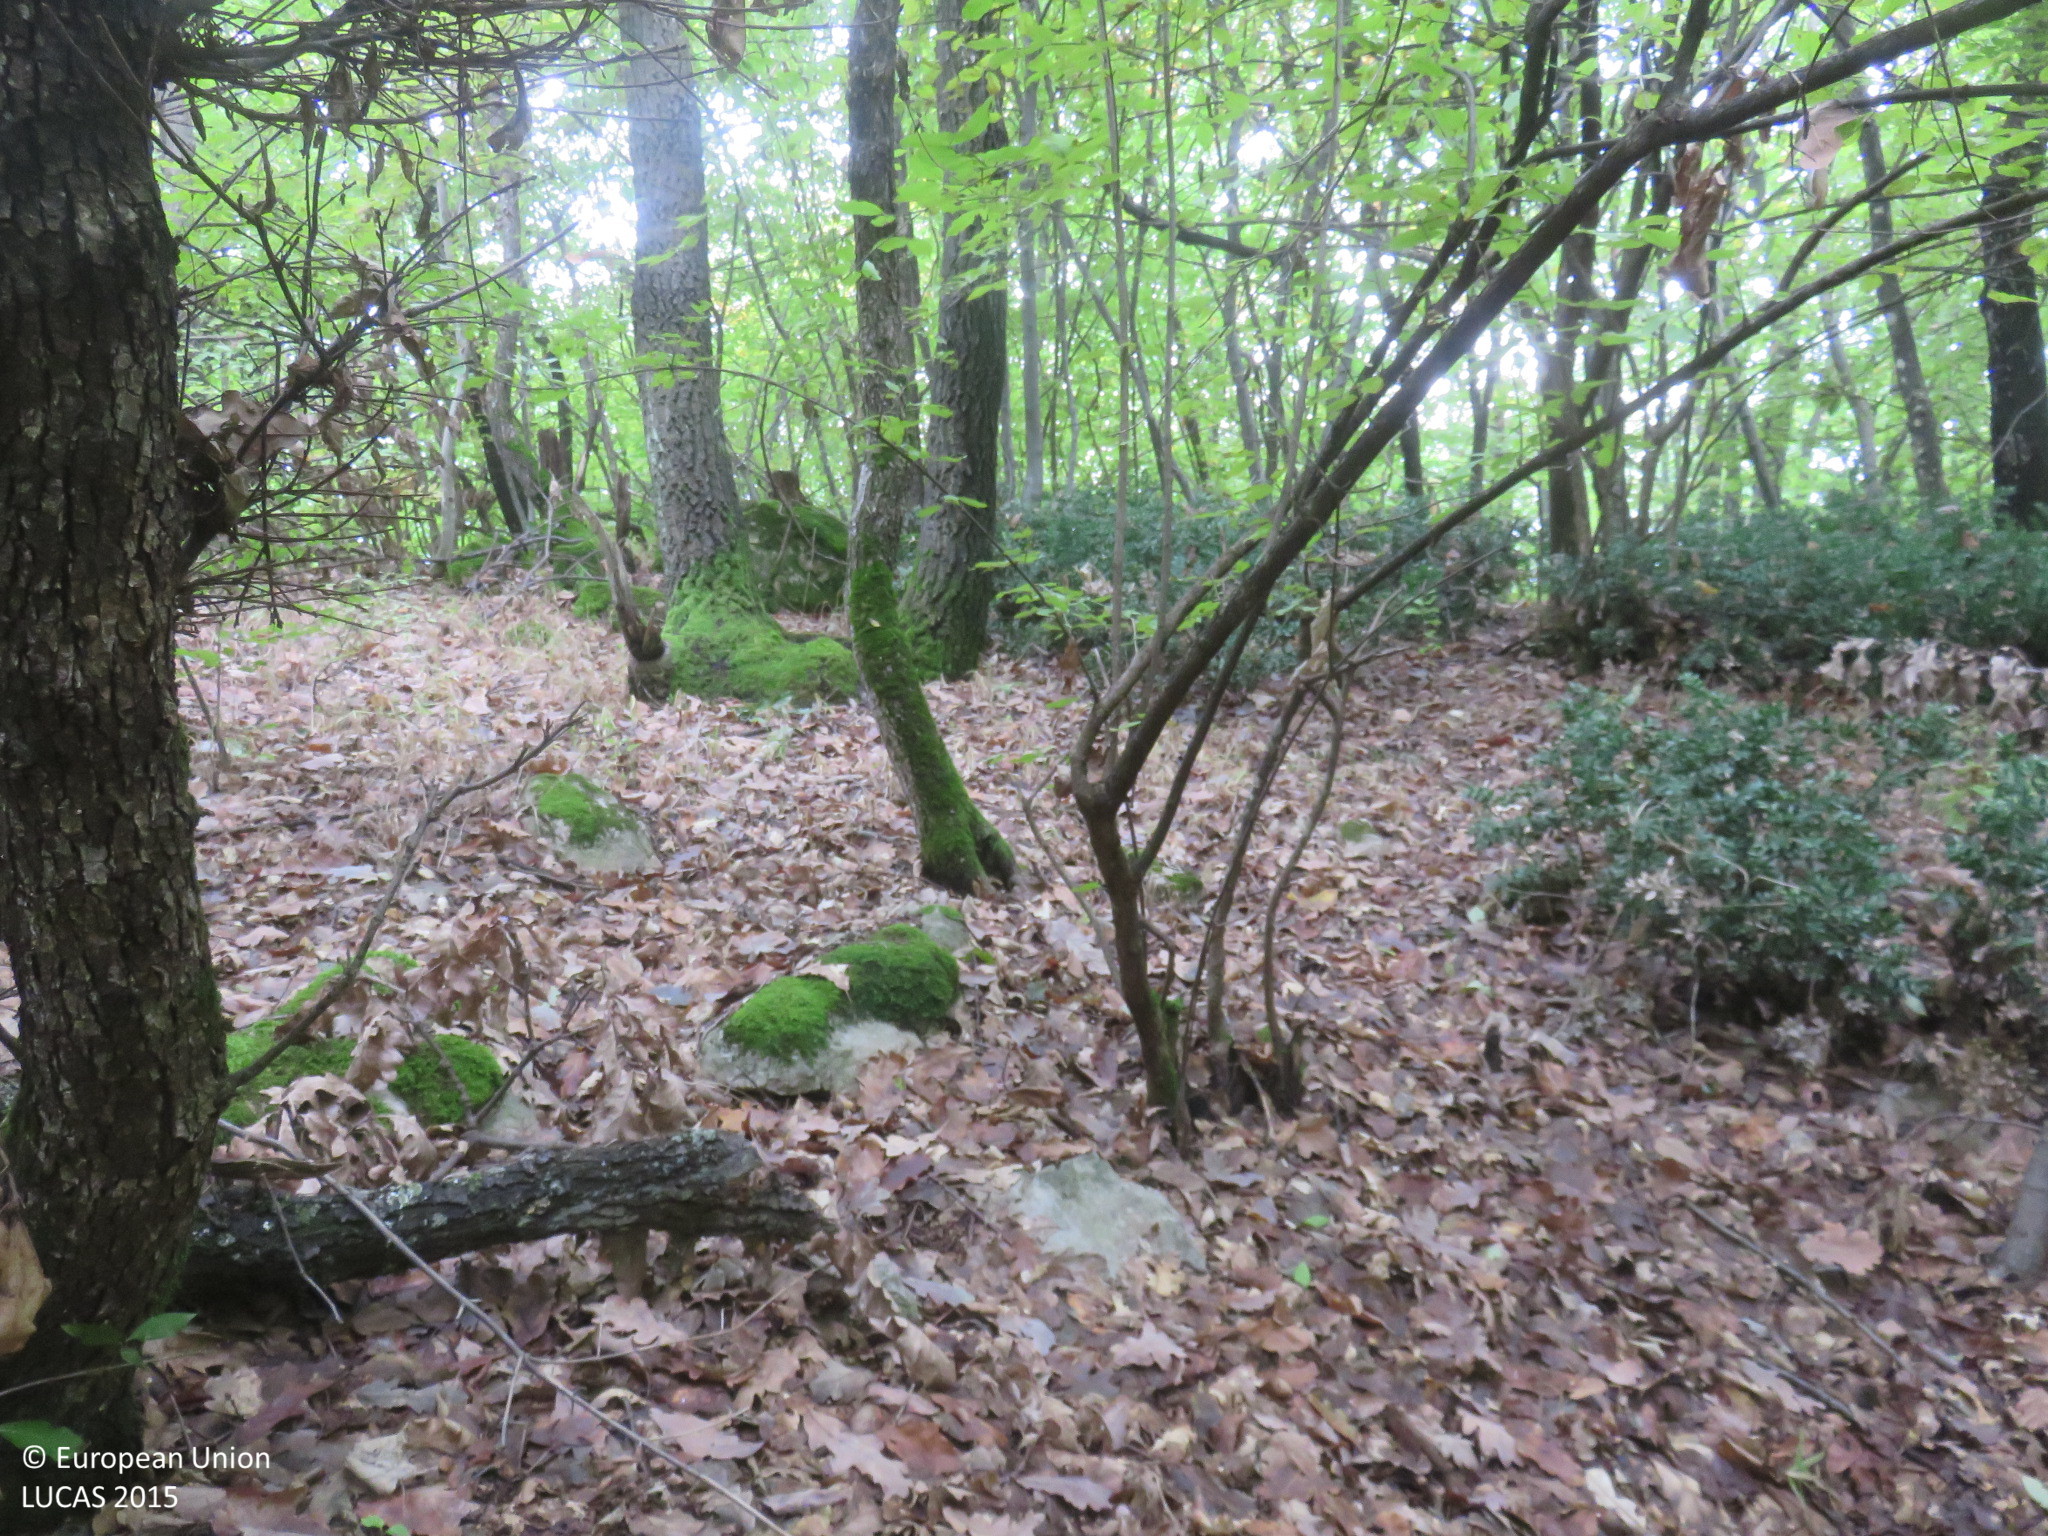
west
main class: Woodland
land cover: Broadleaved woodland
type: mesophytic deciduous forest
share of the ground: > 75 %
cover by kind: broadleaved forest trees 85 %, unconsolidated bare surface 10 %, herbaceous plants 5 %
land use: Forestry
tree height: > 5 m
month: October
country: BG
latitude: 42.9793
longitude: 25.1141
